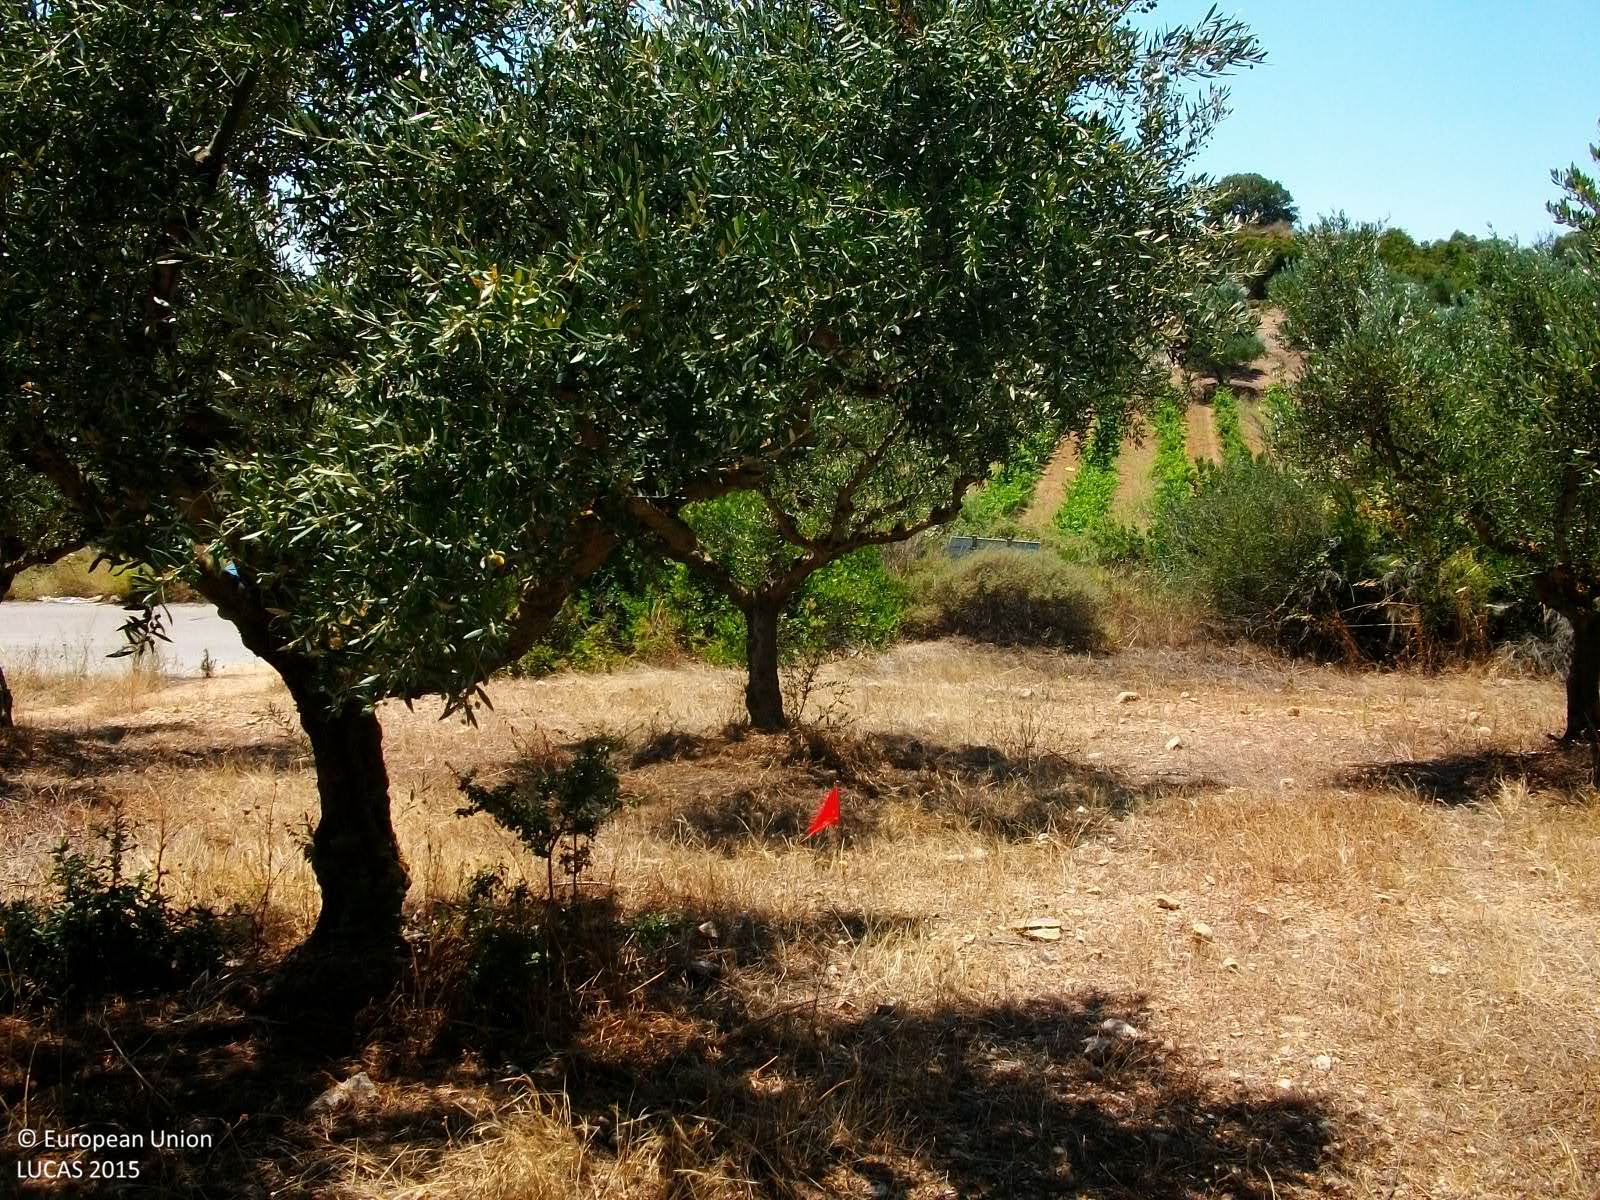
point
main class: Cropland
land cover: Olive groves
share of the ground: 25 - 50 %
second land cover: Spontaneously vegetated surfaces
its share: > 75 %
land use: Agriculture (excluding fallow land and kitchen gardens)
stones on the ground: > 50 %
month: July
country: GR
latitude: 36.8752
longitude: 21.8530
